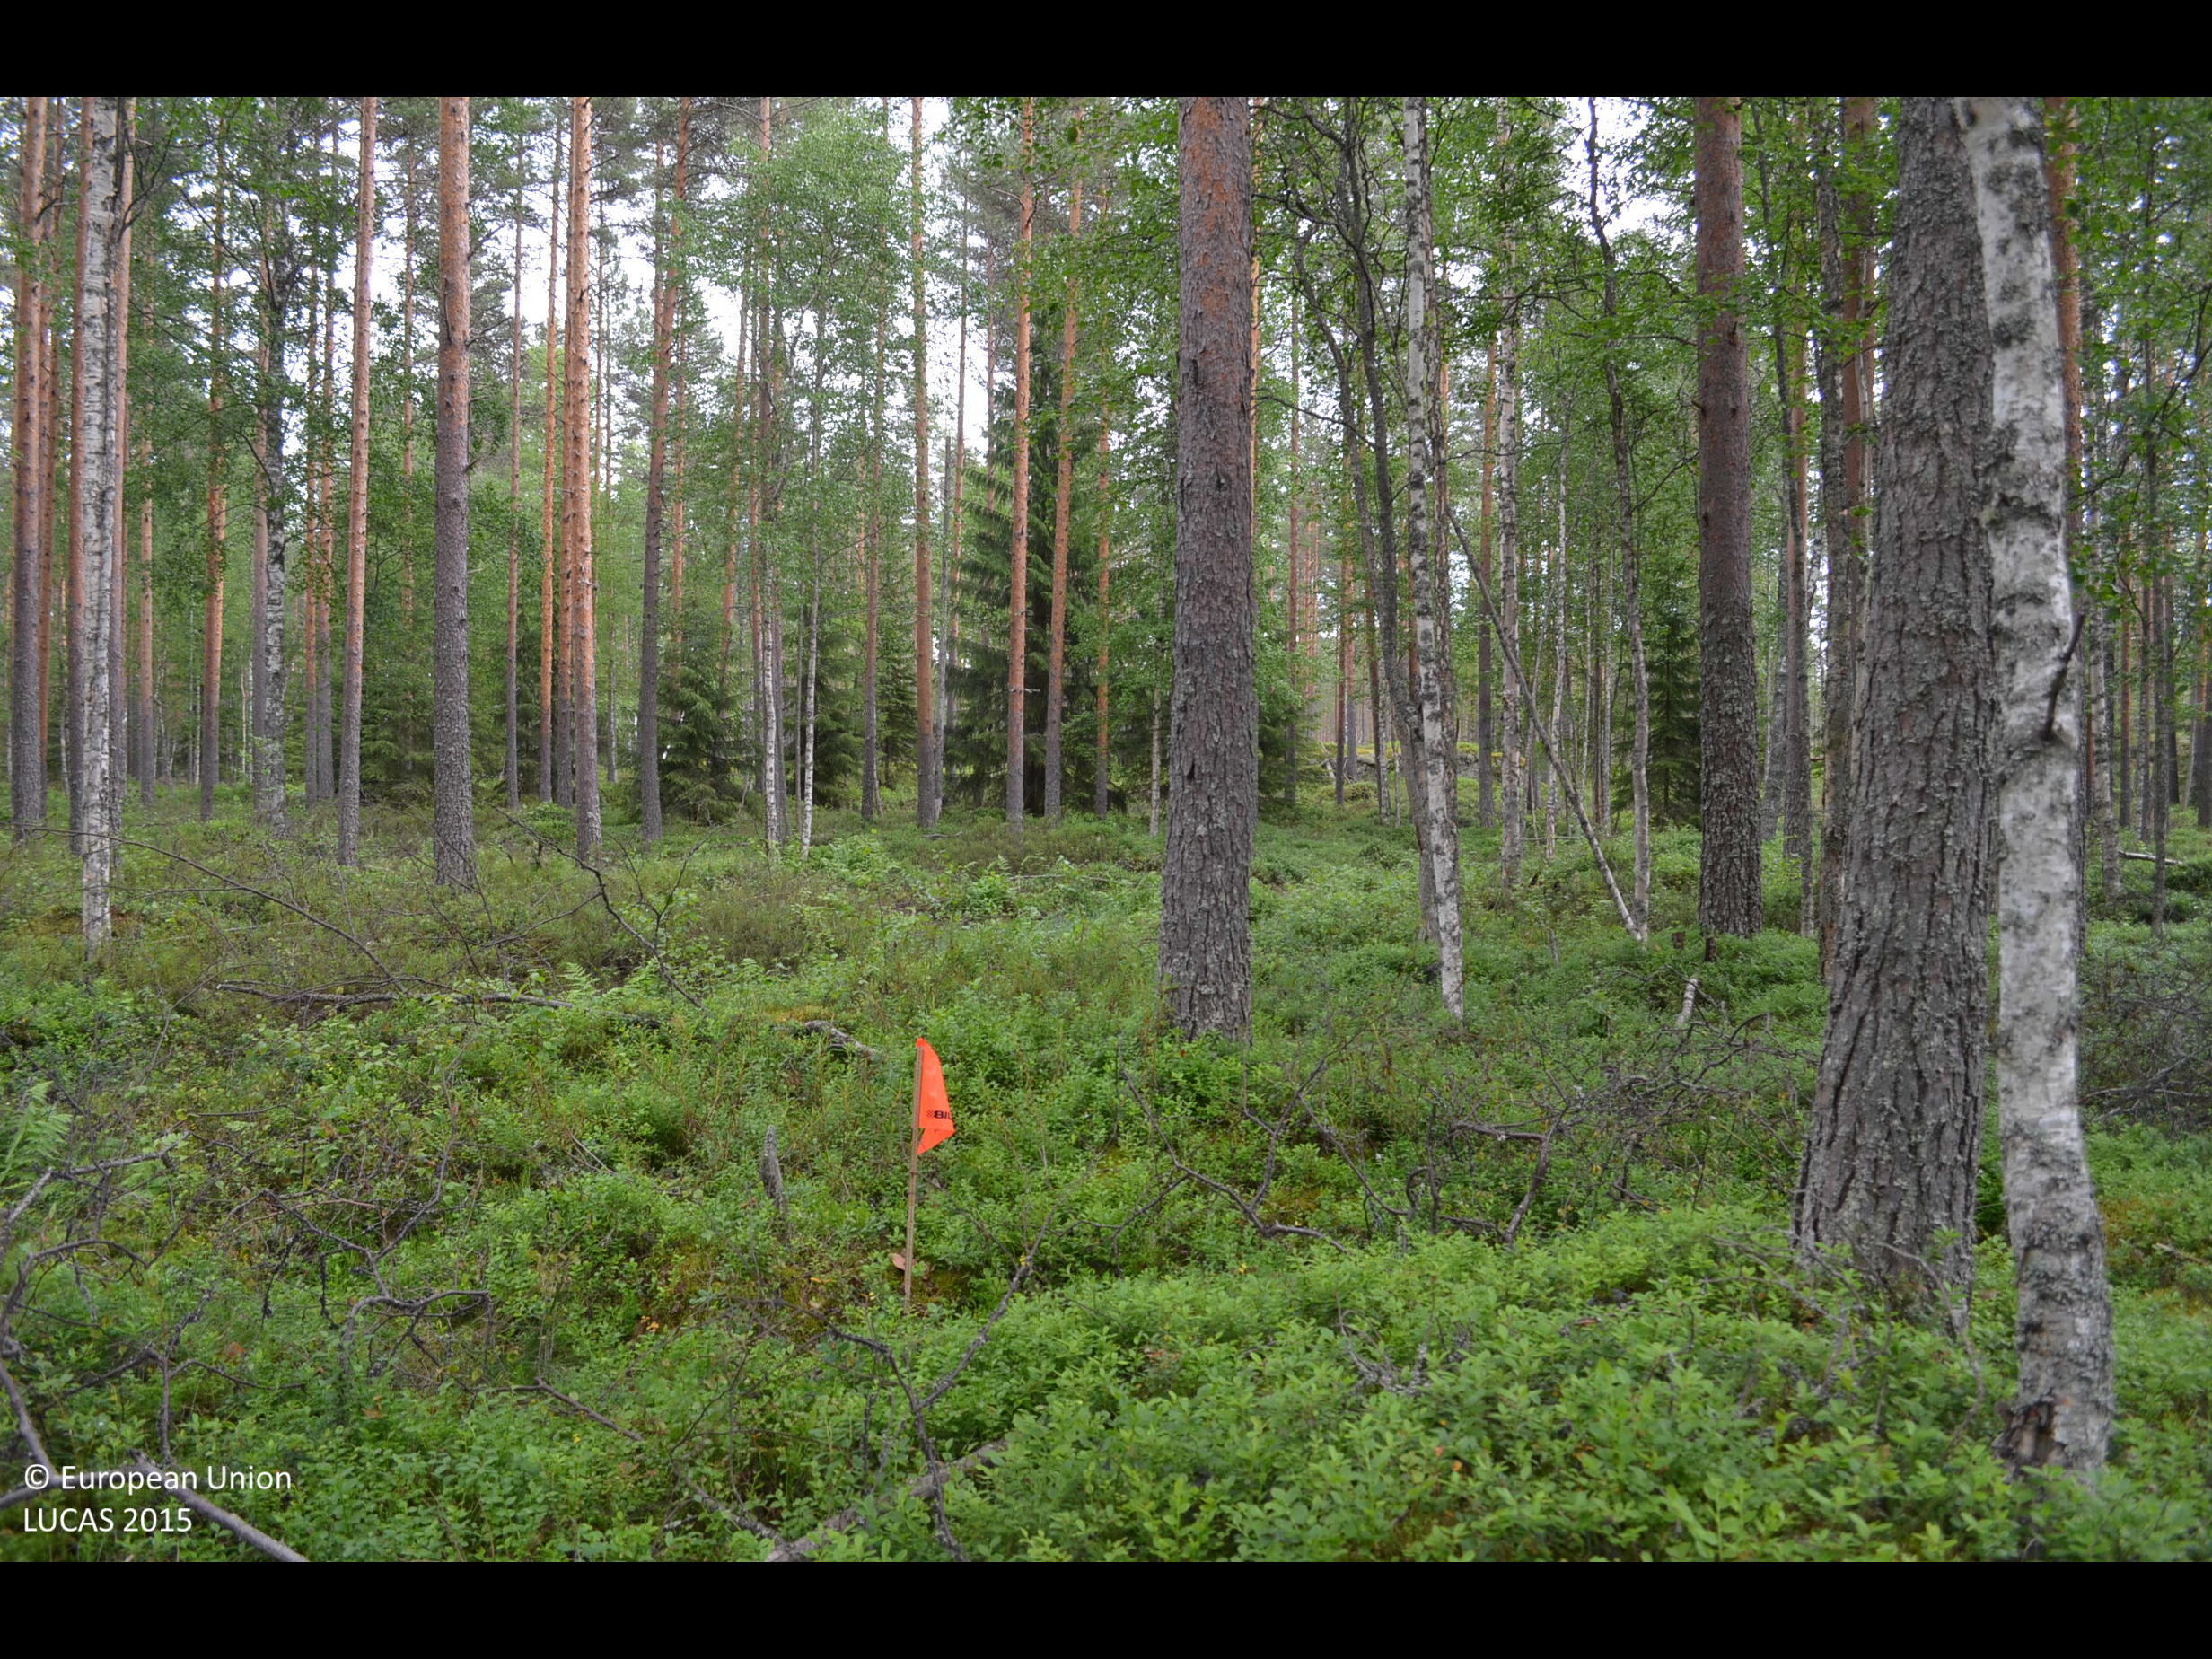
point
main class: Woodland
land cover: Pine dominated mixed woodland
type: boreal forest
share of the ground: > 75 %
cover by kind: coniferous forest trees 55 %, shrubs 25 %, broadleaved forest trees 20 %
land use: Forestry
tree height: > 5 m
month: July
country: FI
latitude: 62.2511
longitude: 23.5704
